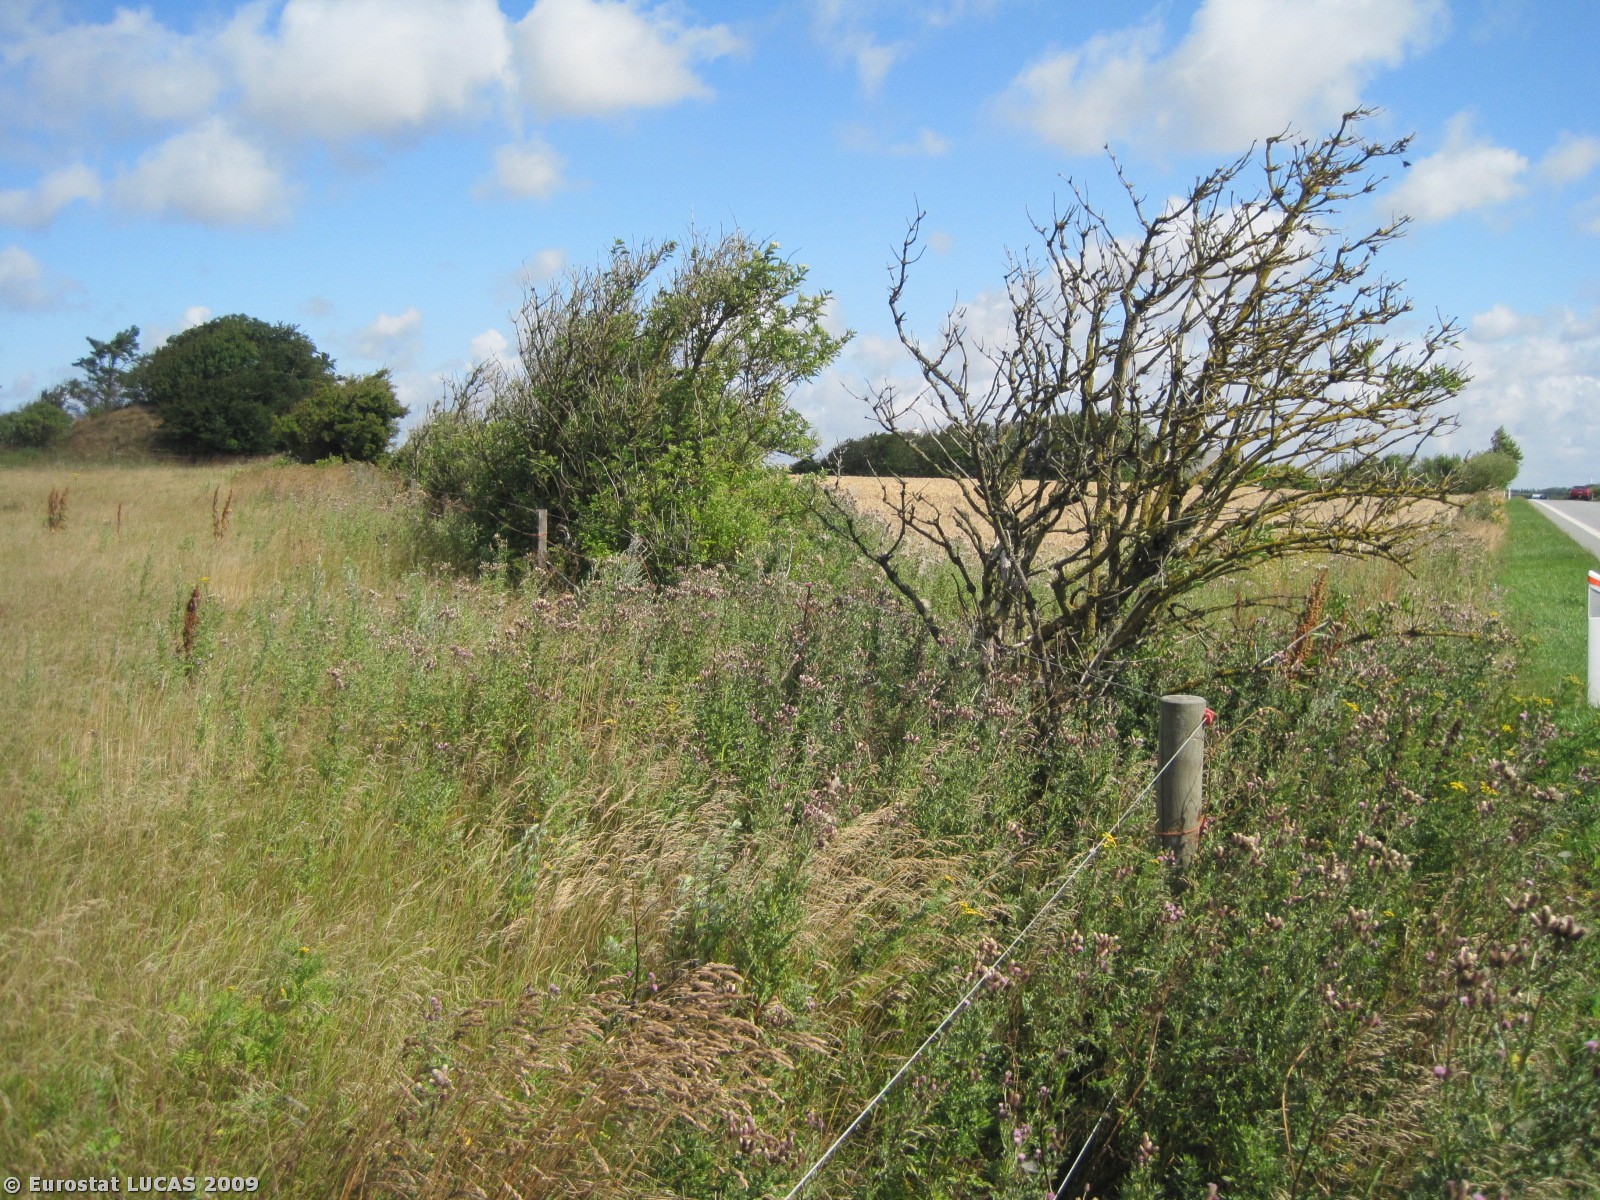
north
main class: Grassland
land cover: Grassland without tree/shrub cover
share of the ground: > 75 %
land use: Agriculture (excluding fallow land and kitchen gardens)
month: July
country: DK
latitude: 56.7174
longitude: 8.4172
